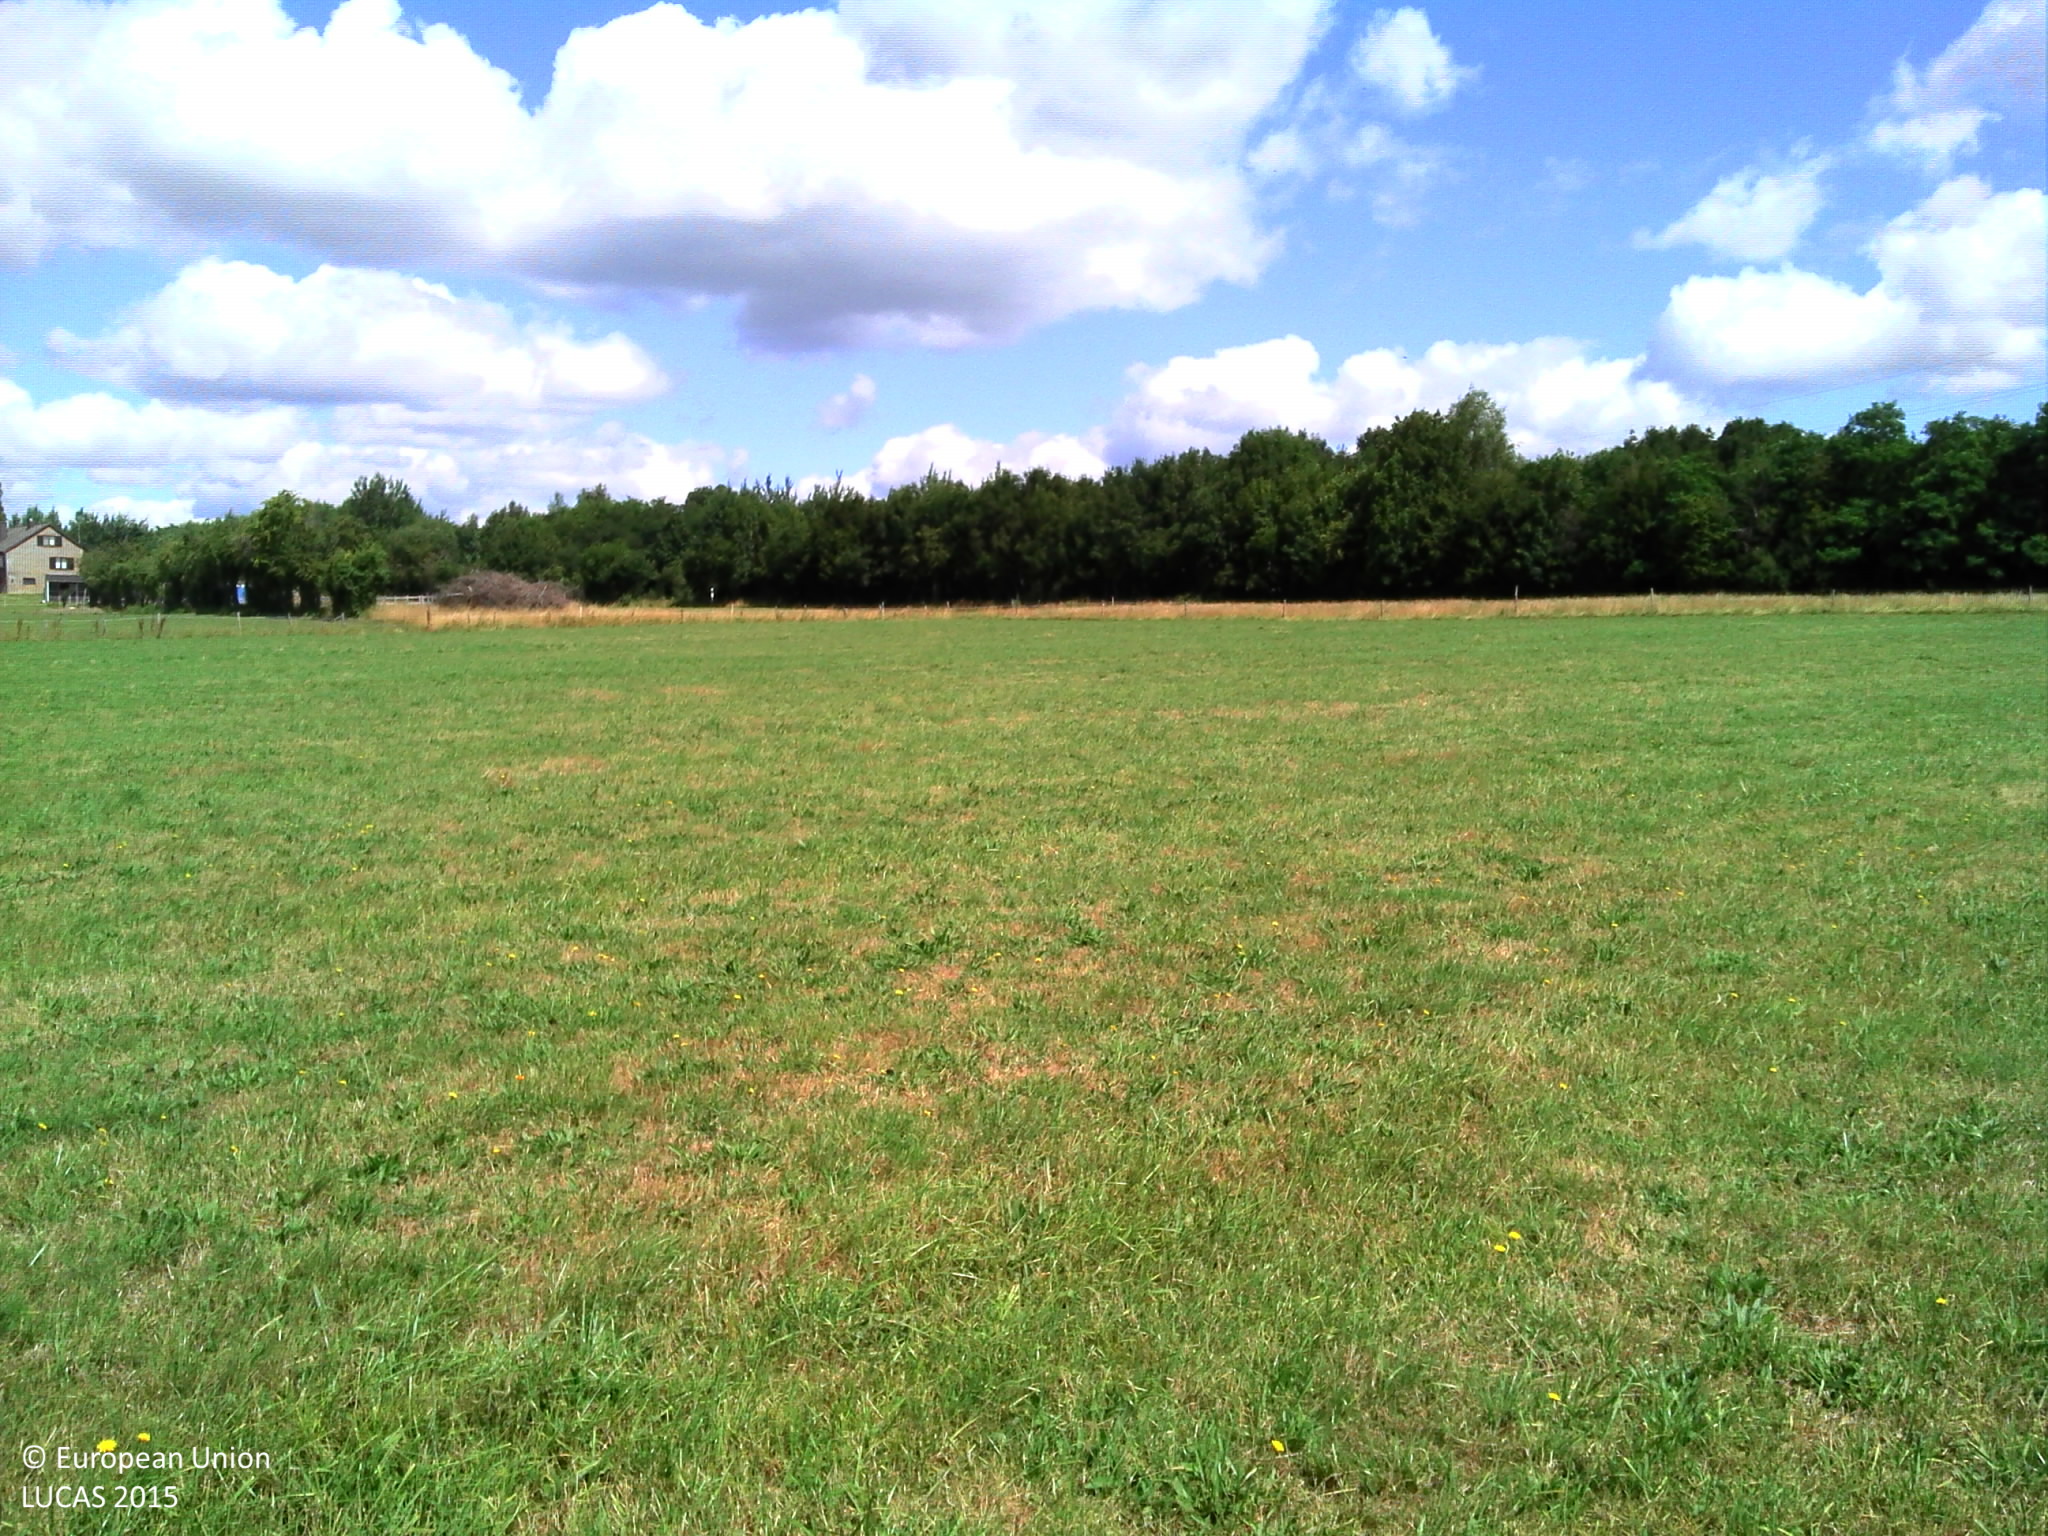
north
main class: Grassland
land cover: Grassland without tree/shrub cover
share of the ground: > 75 %
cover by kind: herbaceous plants 100 %
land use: Agriculture (excluding fallow land and kitchen gardens)
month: July
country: BE
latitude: 49.7191
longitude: 5.5462
